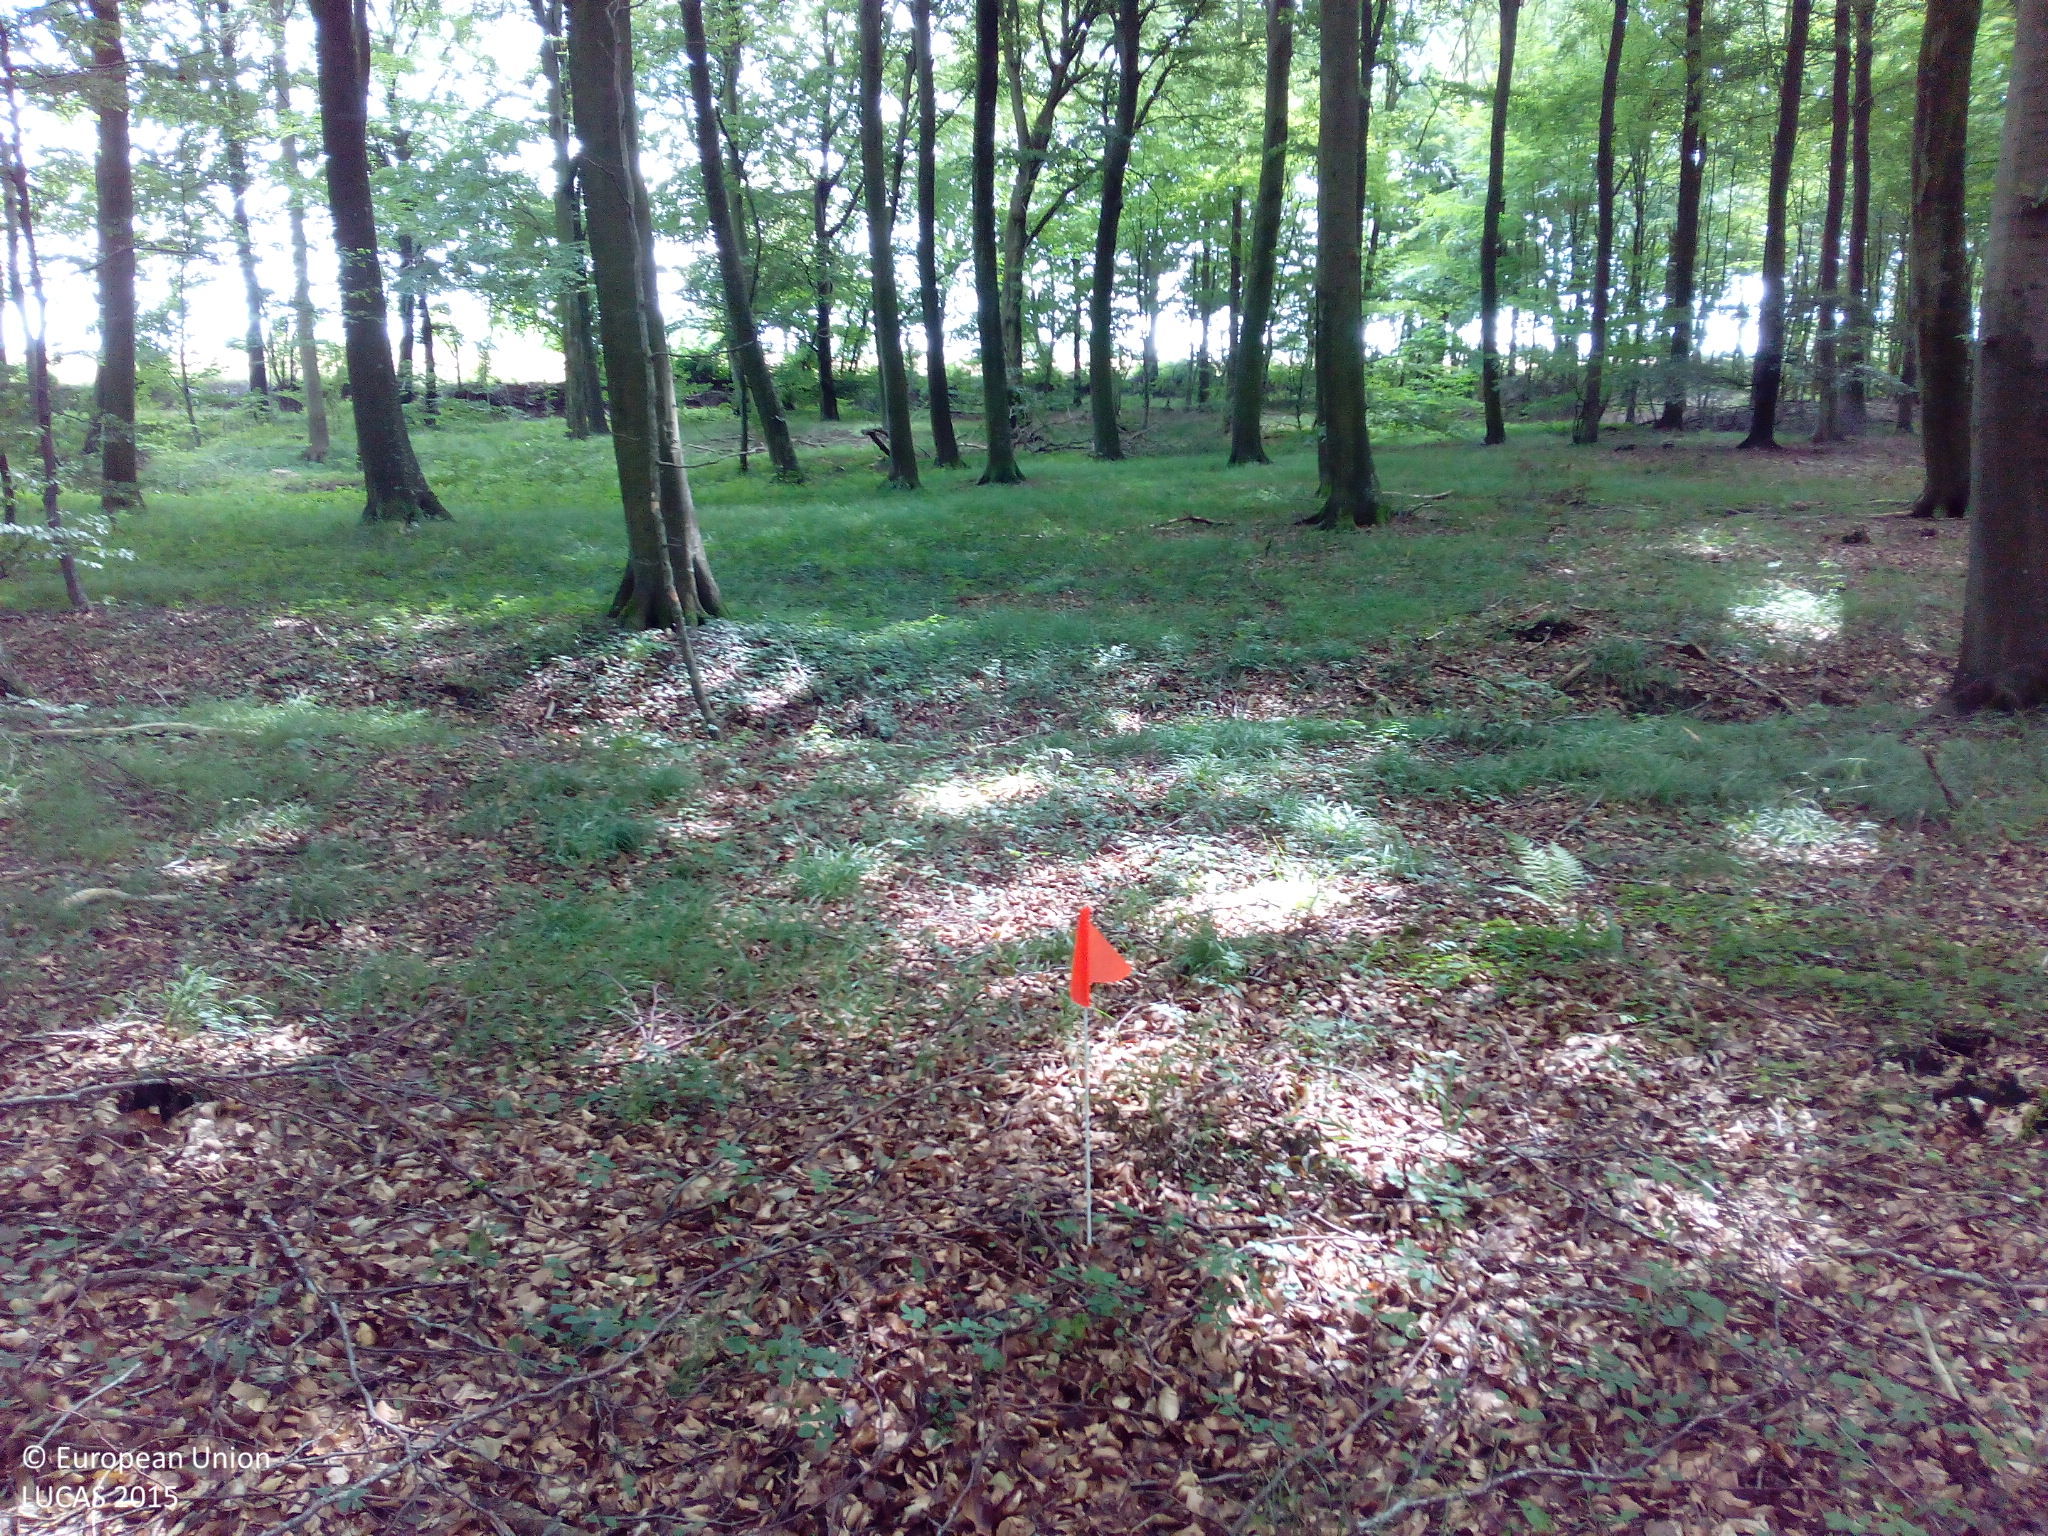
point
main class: Woodland
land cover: Broadleaved woodland
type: beech forest
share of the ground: > 75 %
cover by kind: broadleaved forest trees 80 %, herbaceous plants 10 %, unconsolidated bare surface 10 %
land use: Forestry
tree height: > 5 m
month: August
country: DK
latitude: 55.3779
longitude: 12.1920
